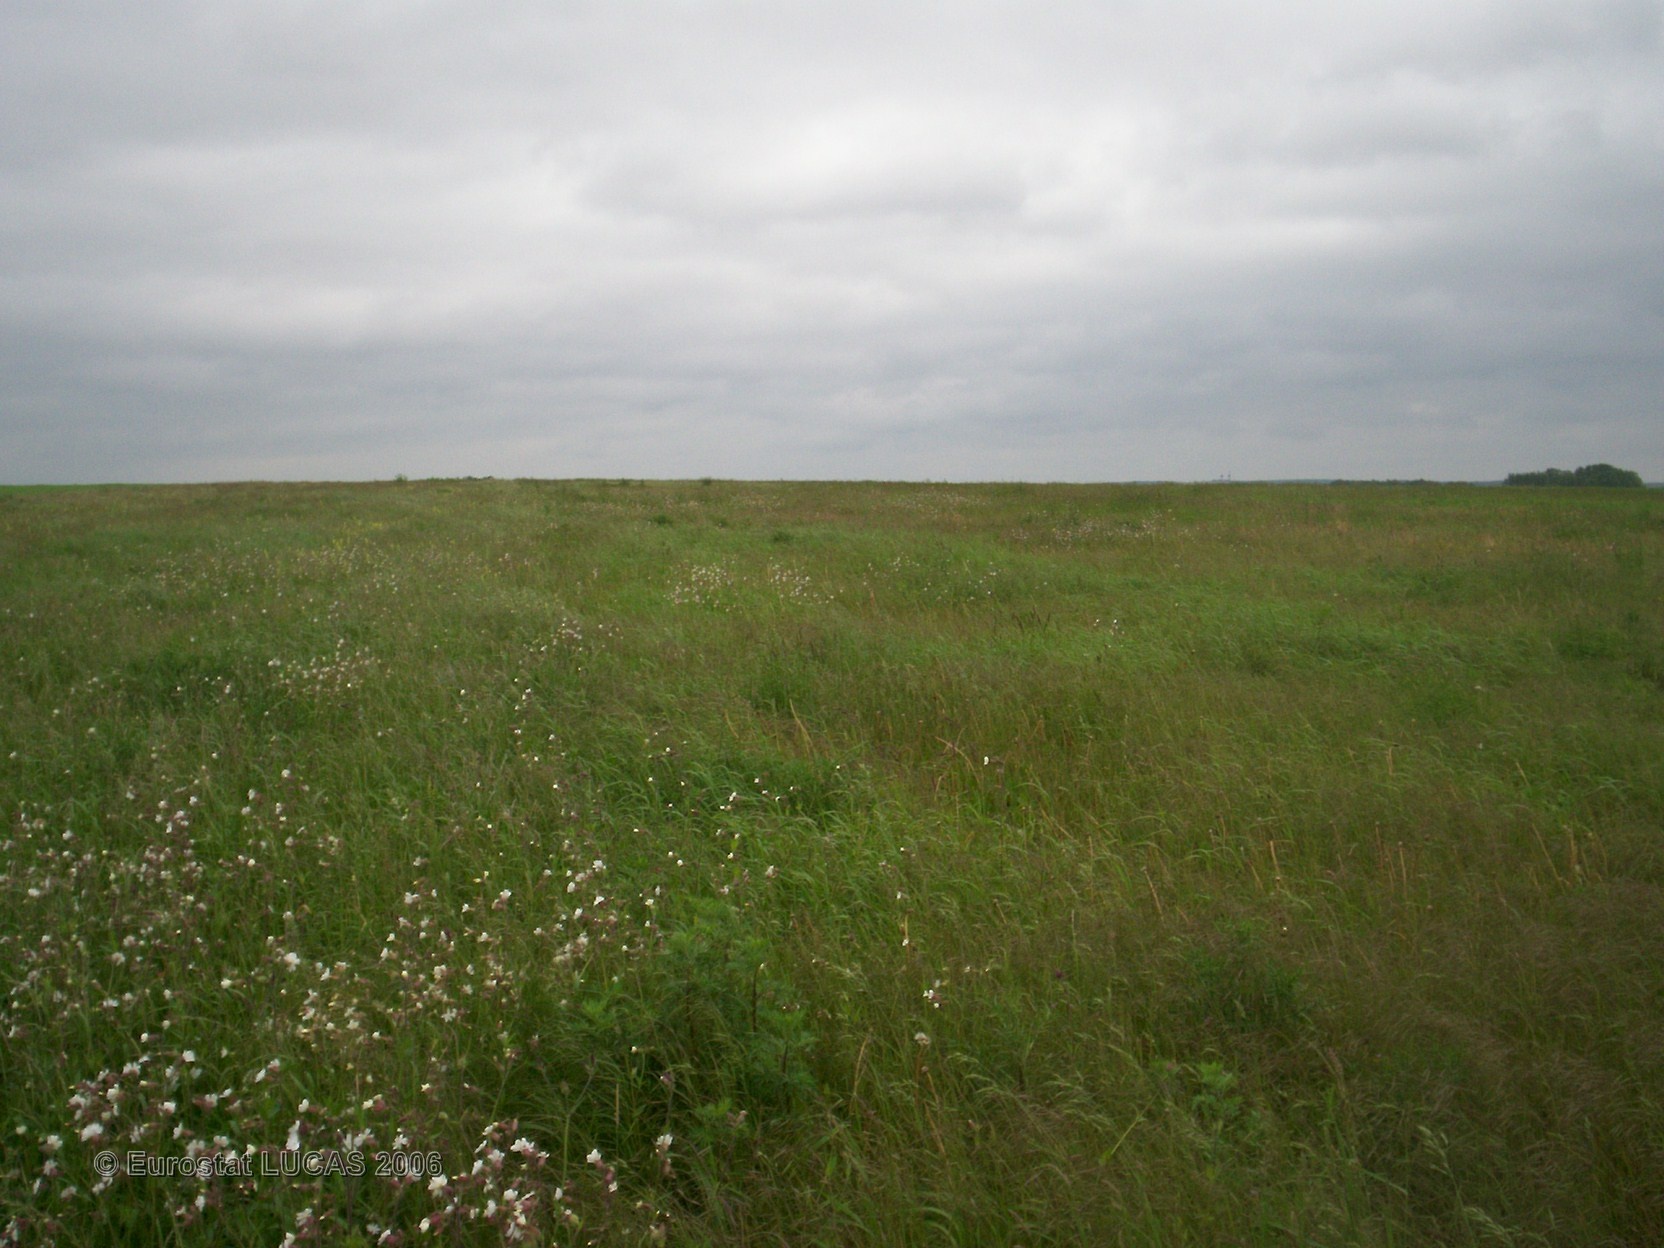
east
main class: Grassland
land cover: Grassland without tree/shrub cover
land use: Fallow land
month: May
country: FR
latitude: 49.3088
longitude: 4.4257
